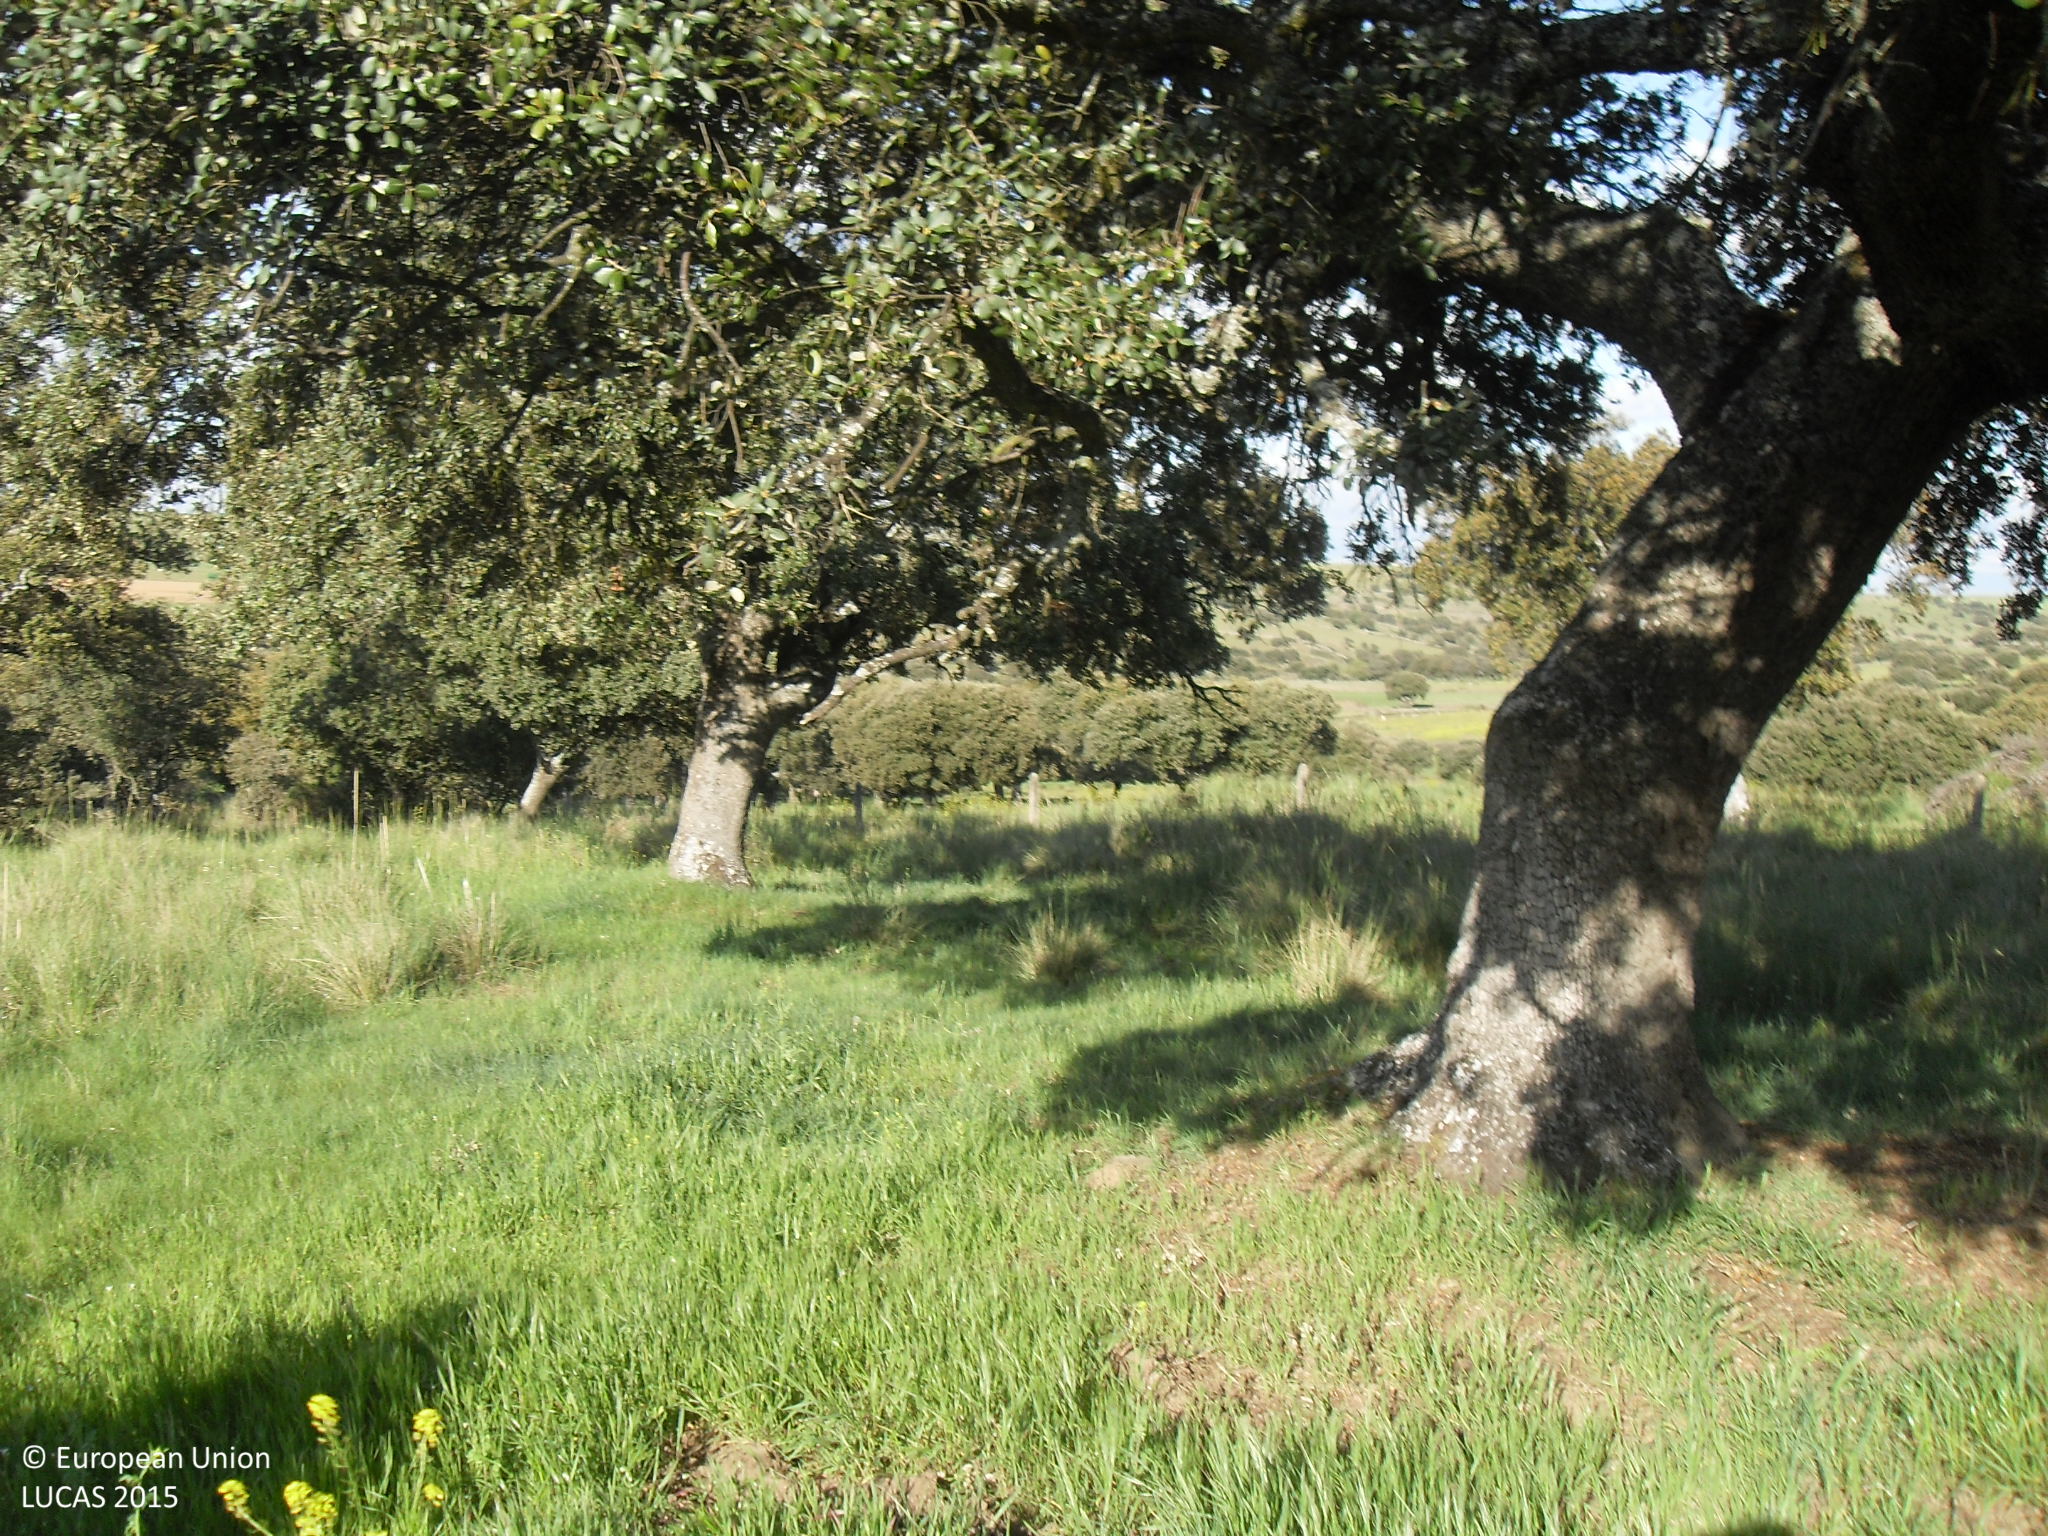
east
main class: Woodland
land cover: Broadleaved woodland
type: broadleaved evergreen forest
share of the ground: 10 - 25 %
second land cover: Grassland without tree/shrub cover
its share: > 75 %
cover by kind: herbaceous plants 80 %, broadleaved forest trees 20 %
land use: Forestry
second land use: Agriculture (excluding fallow land and kitchen gardens)
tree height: > 5 m
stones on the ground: < 10 %
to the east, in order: Broadleaved woodland; Grassland without tree/shrub cover; Fences; Broadleaved woodland; Fences; Broadleaved woodland
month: May
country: ES
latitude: 40.6558
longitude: -5.3114
